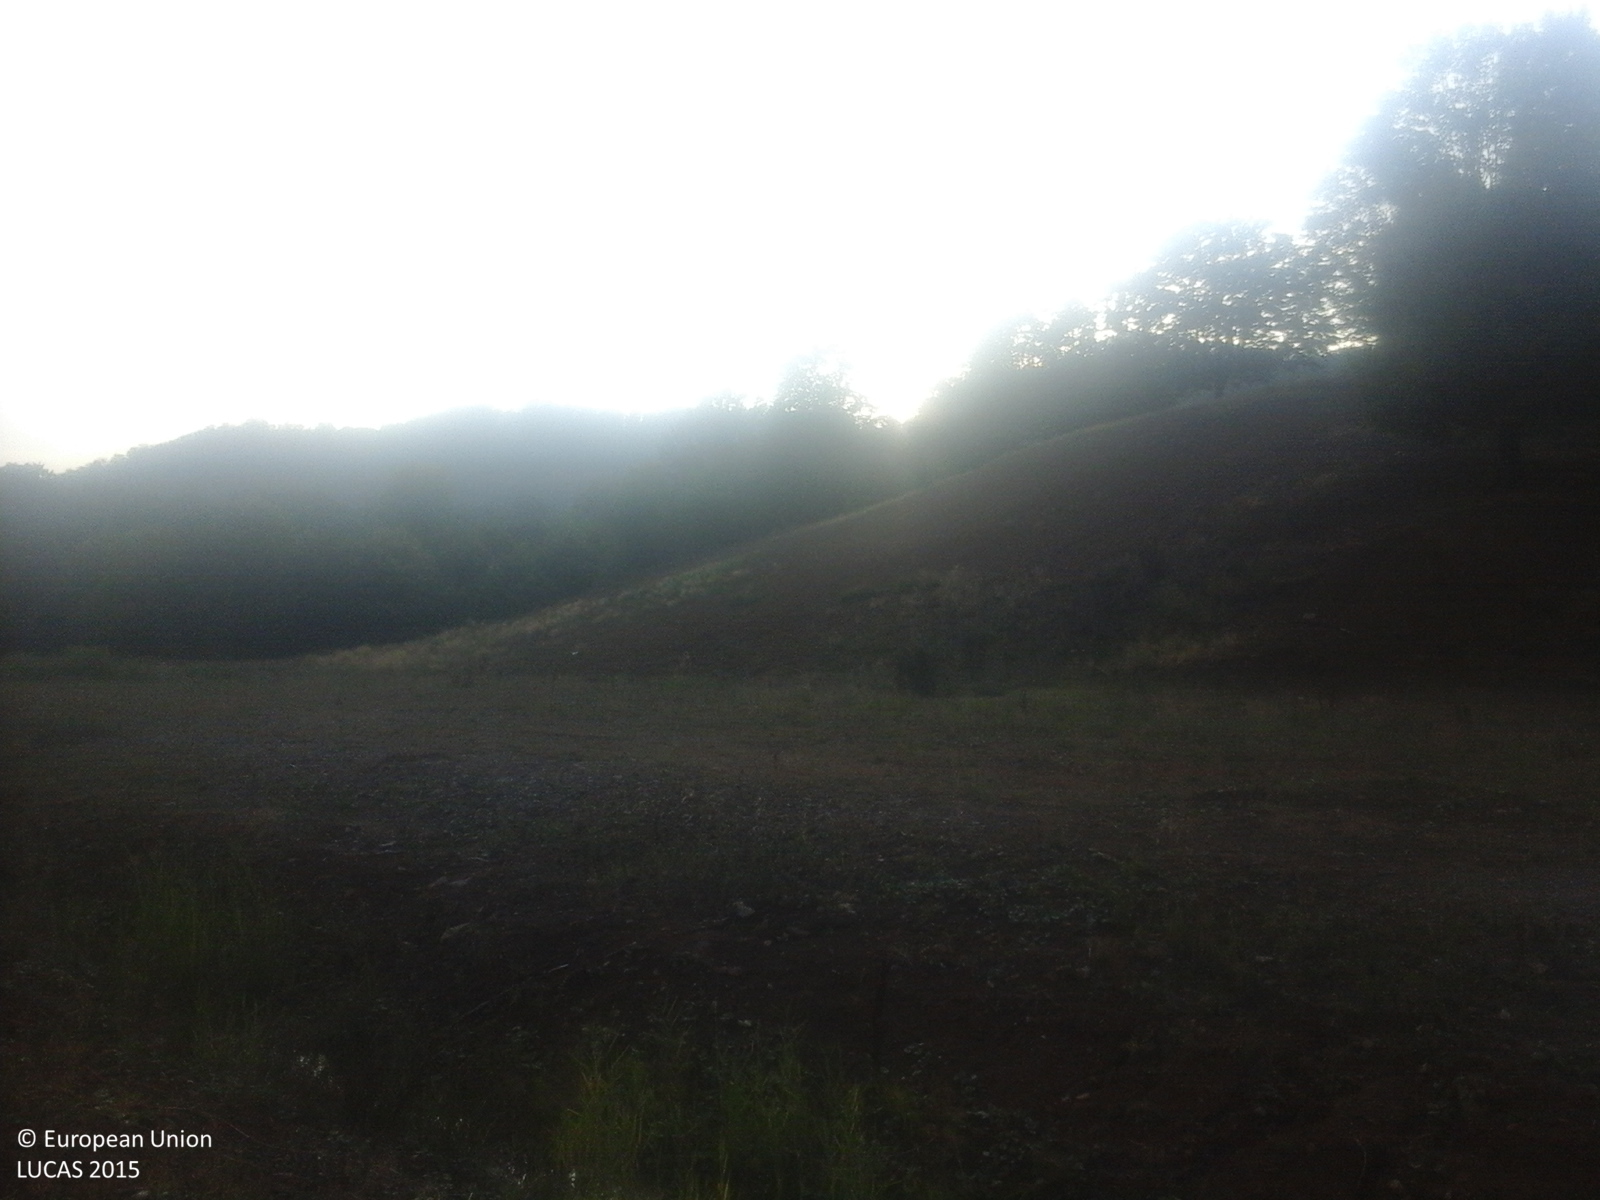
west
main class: Grassland
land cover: Grassland without tree/shrub cover
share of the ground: 50 - 75 %
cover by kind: herbaceous plants 100 %
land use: Agriculture (excluding fallow land and kitchen gardens)
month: September
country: RO
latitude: 47.6243
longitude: 23.7992
